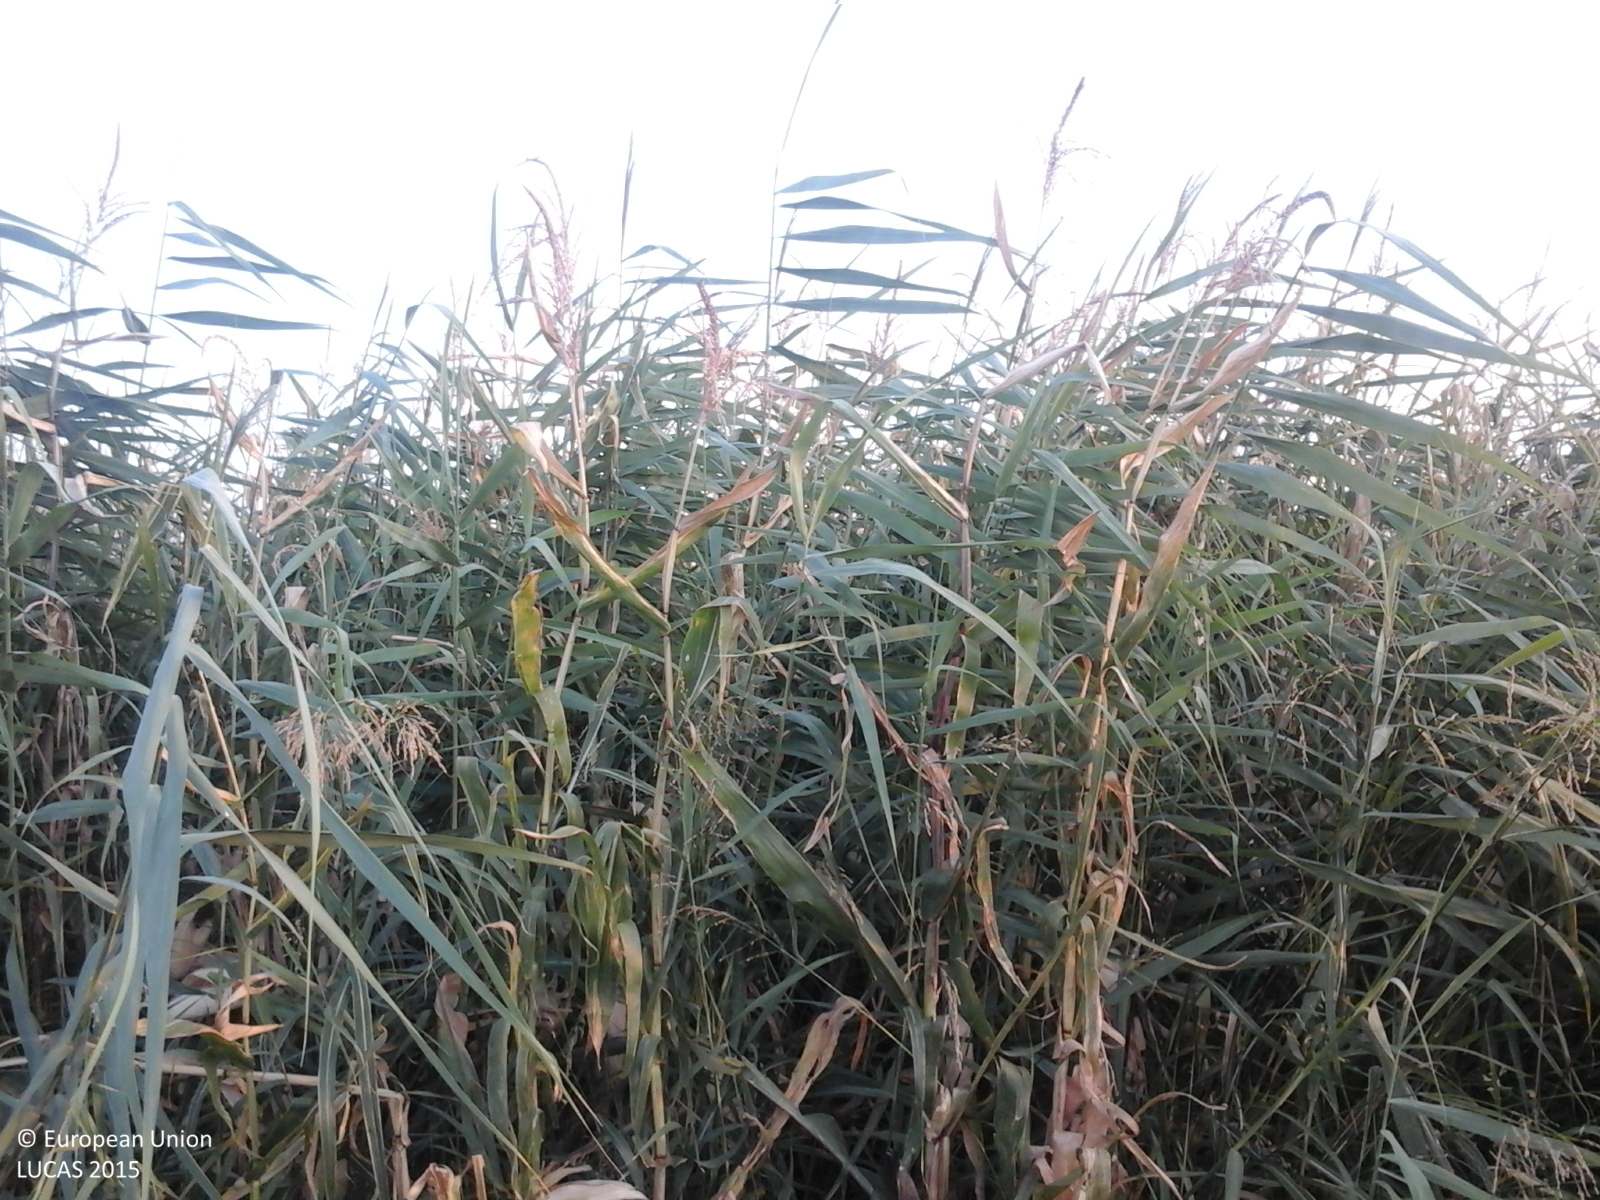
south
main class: Cropland
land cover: Sunflower
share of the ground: > 75 %
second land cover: Spontaneously vegetated surfaces
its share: 50 - 75 %
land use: Agriculture (excluding fallow land and kitchen gardens)
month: August
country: RO
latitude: 43.8900
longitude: 23.4538
